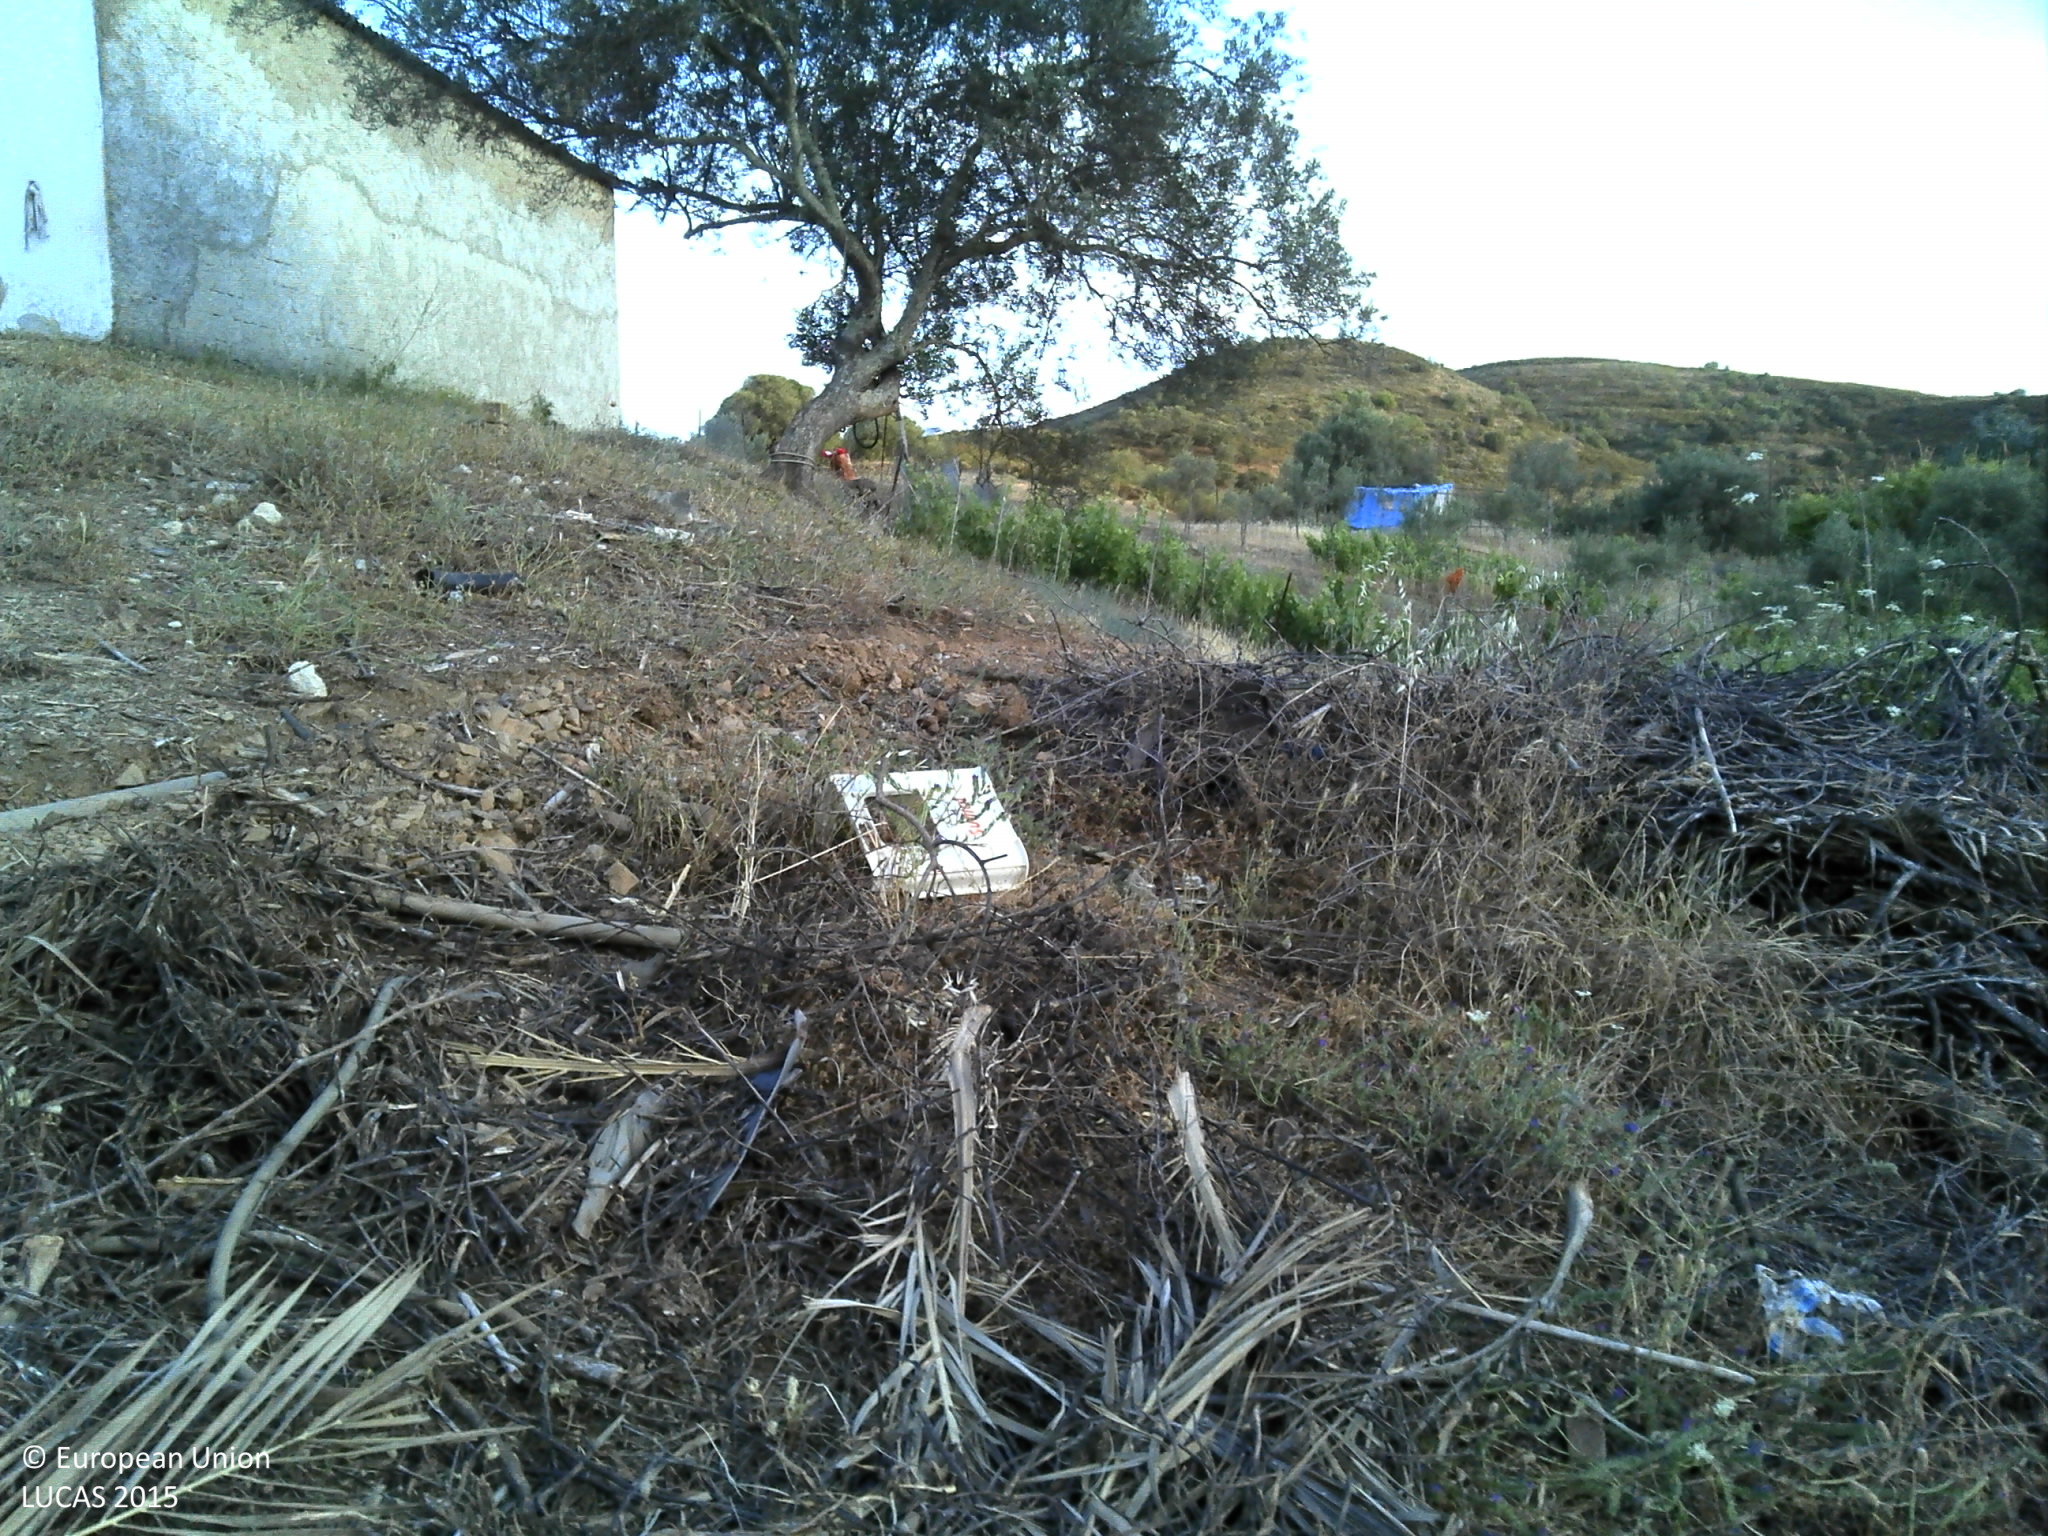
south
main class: Grassland
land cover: Grassland with sparse tree/shrub cover
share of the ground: 25 - 50 %
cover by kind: herbaceous plants 45 %, unconsolidated bare surface 40 %, broadleaved forest trees 5 %
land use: Abandoned areas
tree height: < 5 m
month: May
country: PT
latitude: 37.2769
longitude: -7.4969
